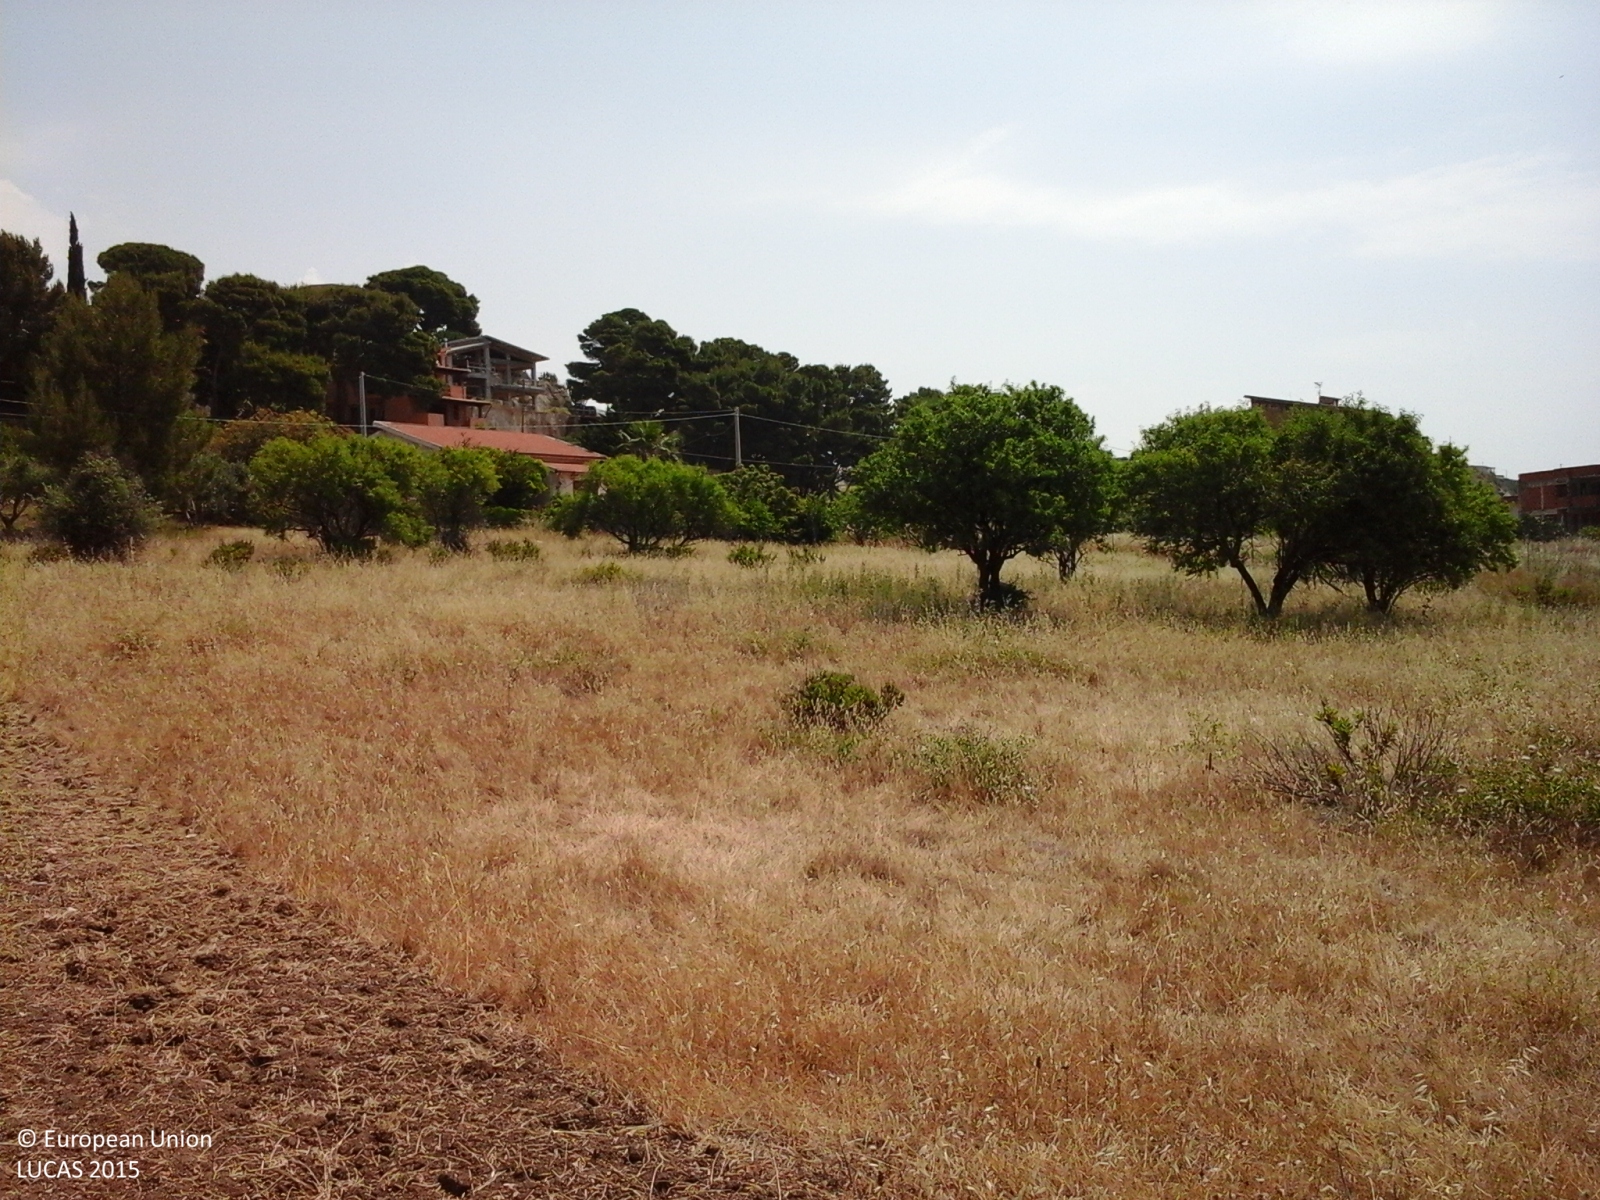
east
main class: Cropland
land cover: Other fruit trees and berries
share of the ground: 25 - 50 %
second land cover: Spontaneously vegetated surfaces
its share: > 75 %
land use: Kitchen garden
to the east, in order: Other fruit trees and berries; Spontaneously vegetated surfaces; Artificial constructions in urban areas; Spontaneously vegetated surfaces; Artificial constructions in urban areas; Spontaneously vegetated surfaces; Electric lines; Spontaneously vegetated surfaces; Paved roads, cycling and walking lanes; Spontaneously vegetated surfaces; Fences; Pine dominated coniferous woodland; Dry stone walls; Paved roads, cycling and walking lanes; Fences; Grassland with sparse tree/shrub cover
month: June
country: IT
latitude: 37.3030
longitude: 13.4590
